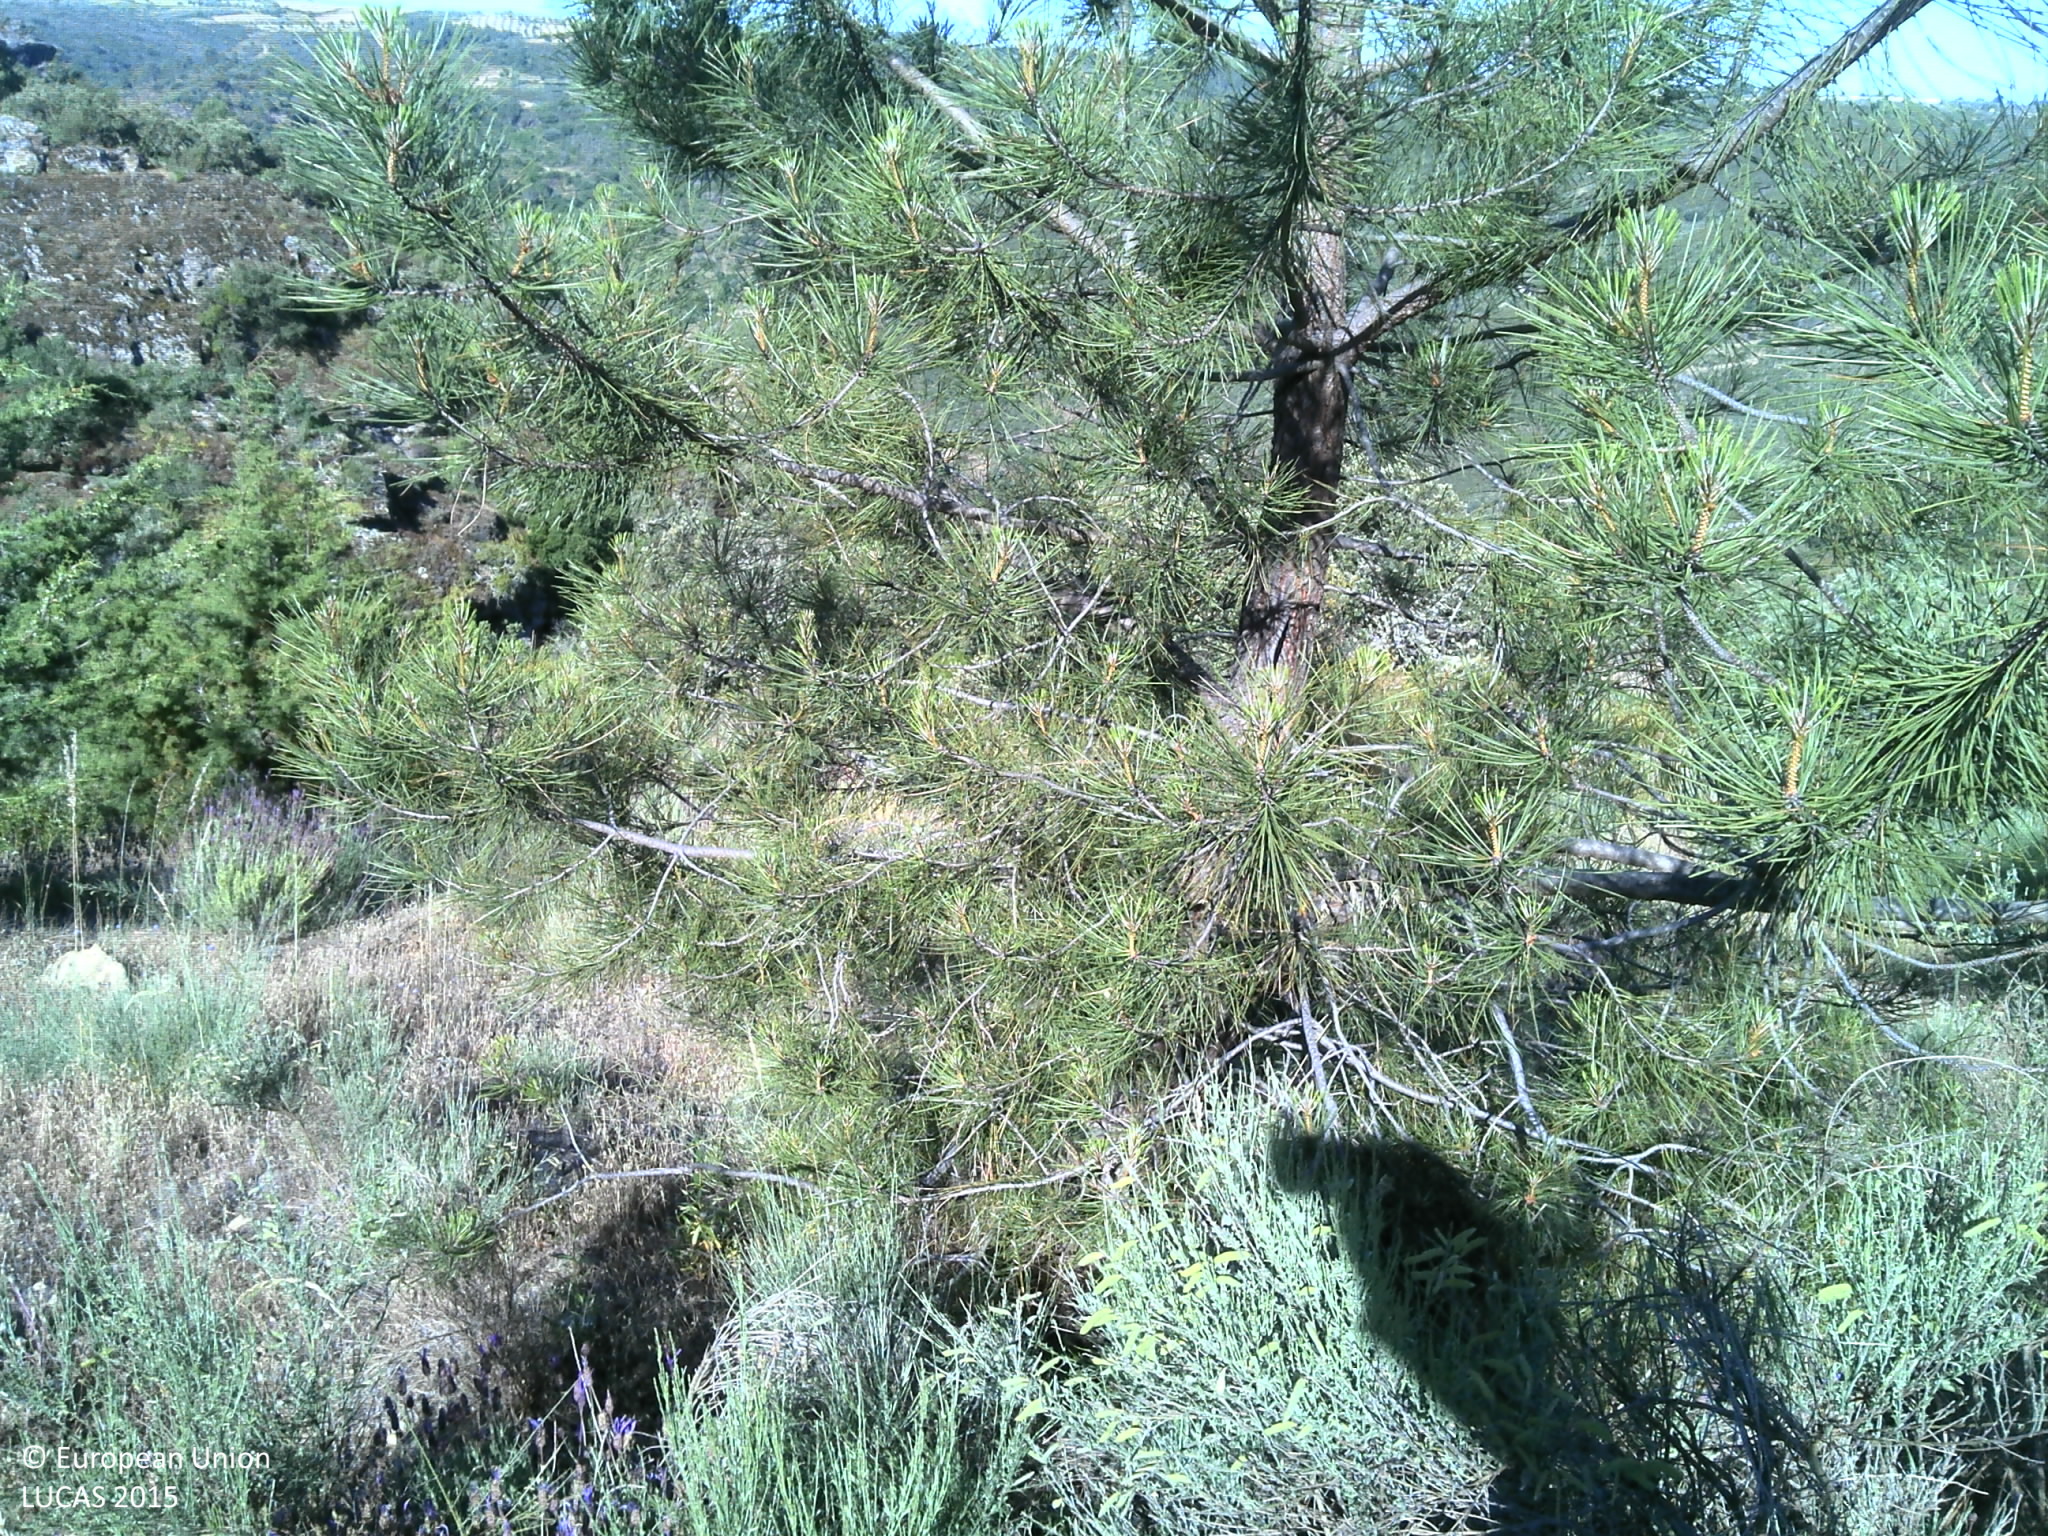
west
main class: Woodland
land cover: Other coniferous woodland
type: coniferous forest of the mediterranean region
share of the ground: 10 - 25 %
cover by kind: shrubs 70 %, coniferous forest trees 10 %, herbaceous plants 10 %, unconsolidated bare surface 10 %
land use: Forestry
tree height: < 5 m
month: May
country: PT
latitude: 41.5937
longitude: -6.5529
